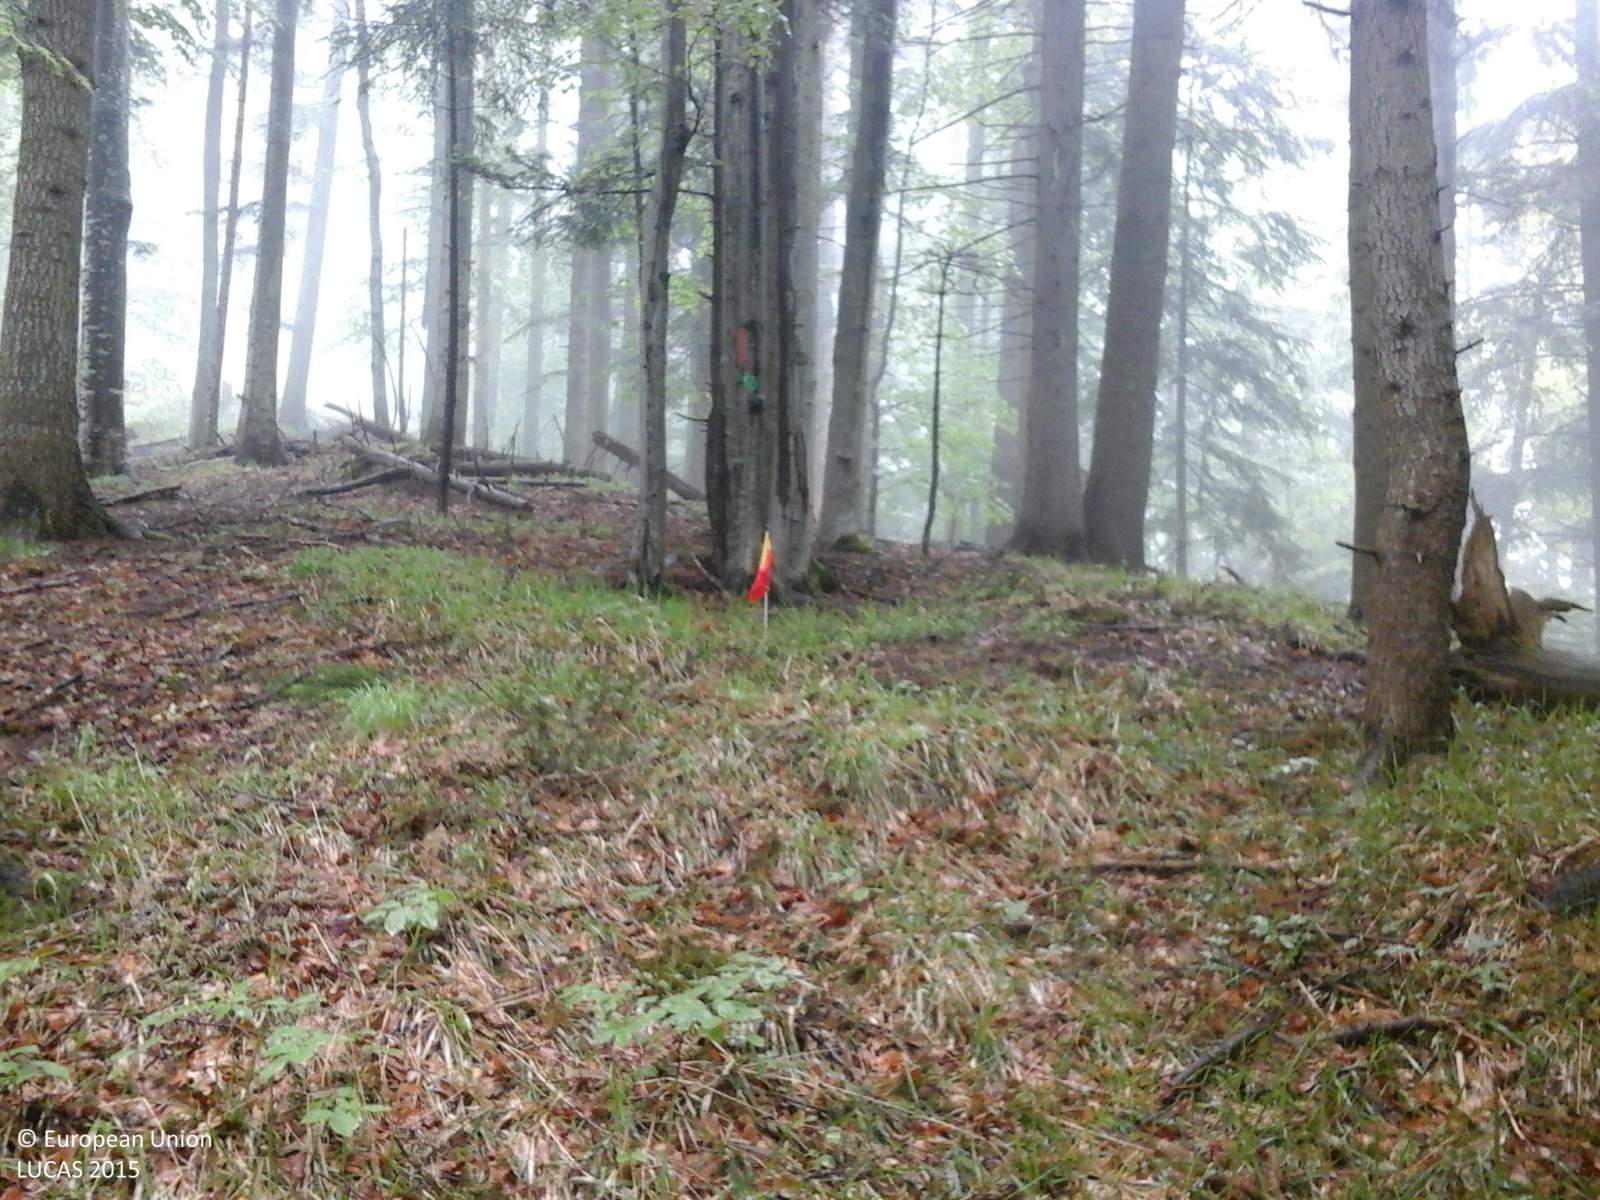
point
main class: Woodland
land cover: Other mixed woodland
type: alpine coniferous forest
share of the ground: > 75 %
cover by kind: coniferous forest trees 65 %, broadleaved forest trees 35 %
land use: Forestry
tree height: > 5 m
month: May
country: RO
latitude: 45.6385
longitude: 25.2213
